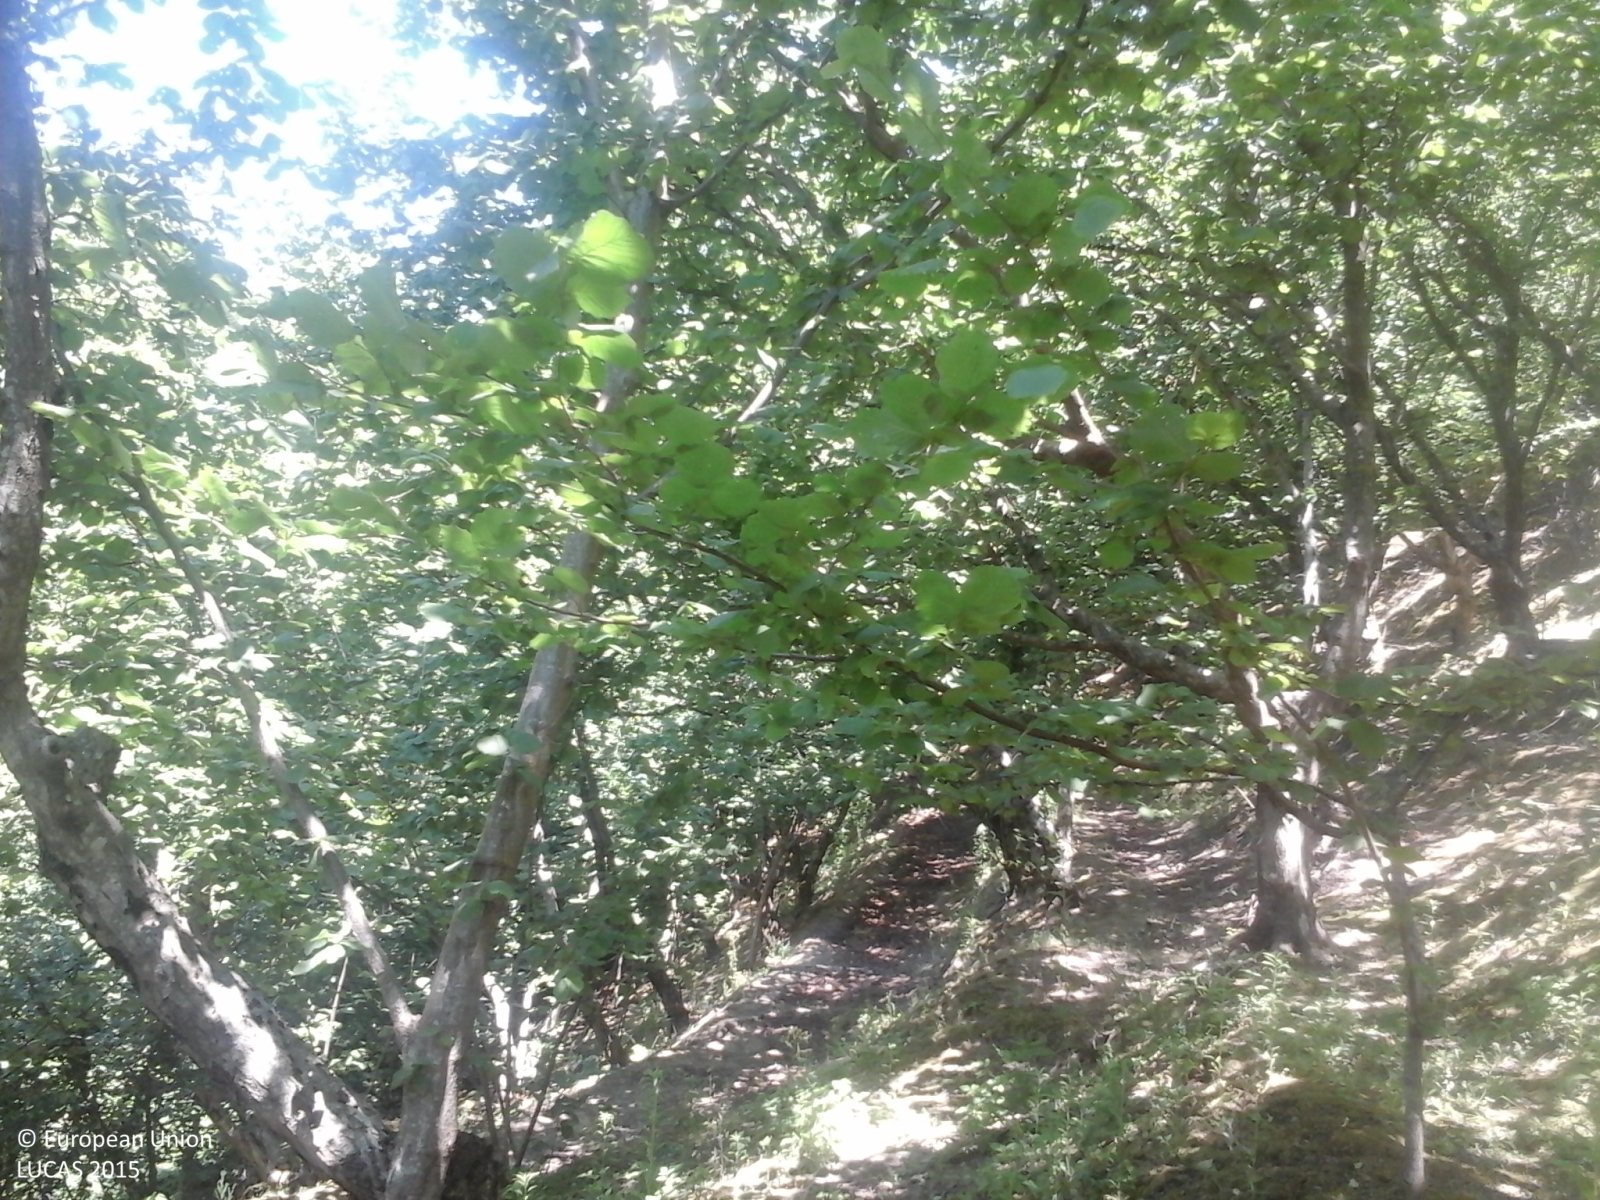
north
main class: Cropland
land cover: Nuts trees
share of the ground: > 75 %
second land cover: Spontaneously vegetated surfaces
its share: > 75 %
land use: Agriculture (excluding fallow land and kitchen gardens)
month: July
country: IT
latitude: 40.8991
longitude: 14.6700
